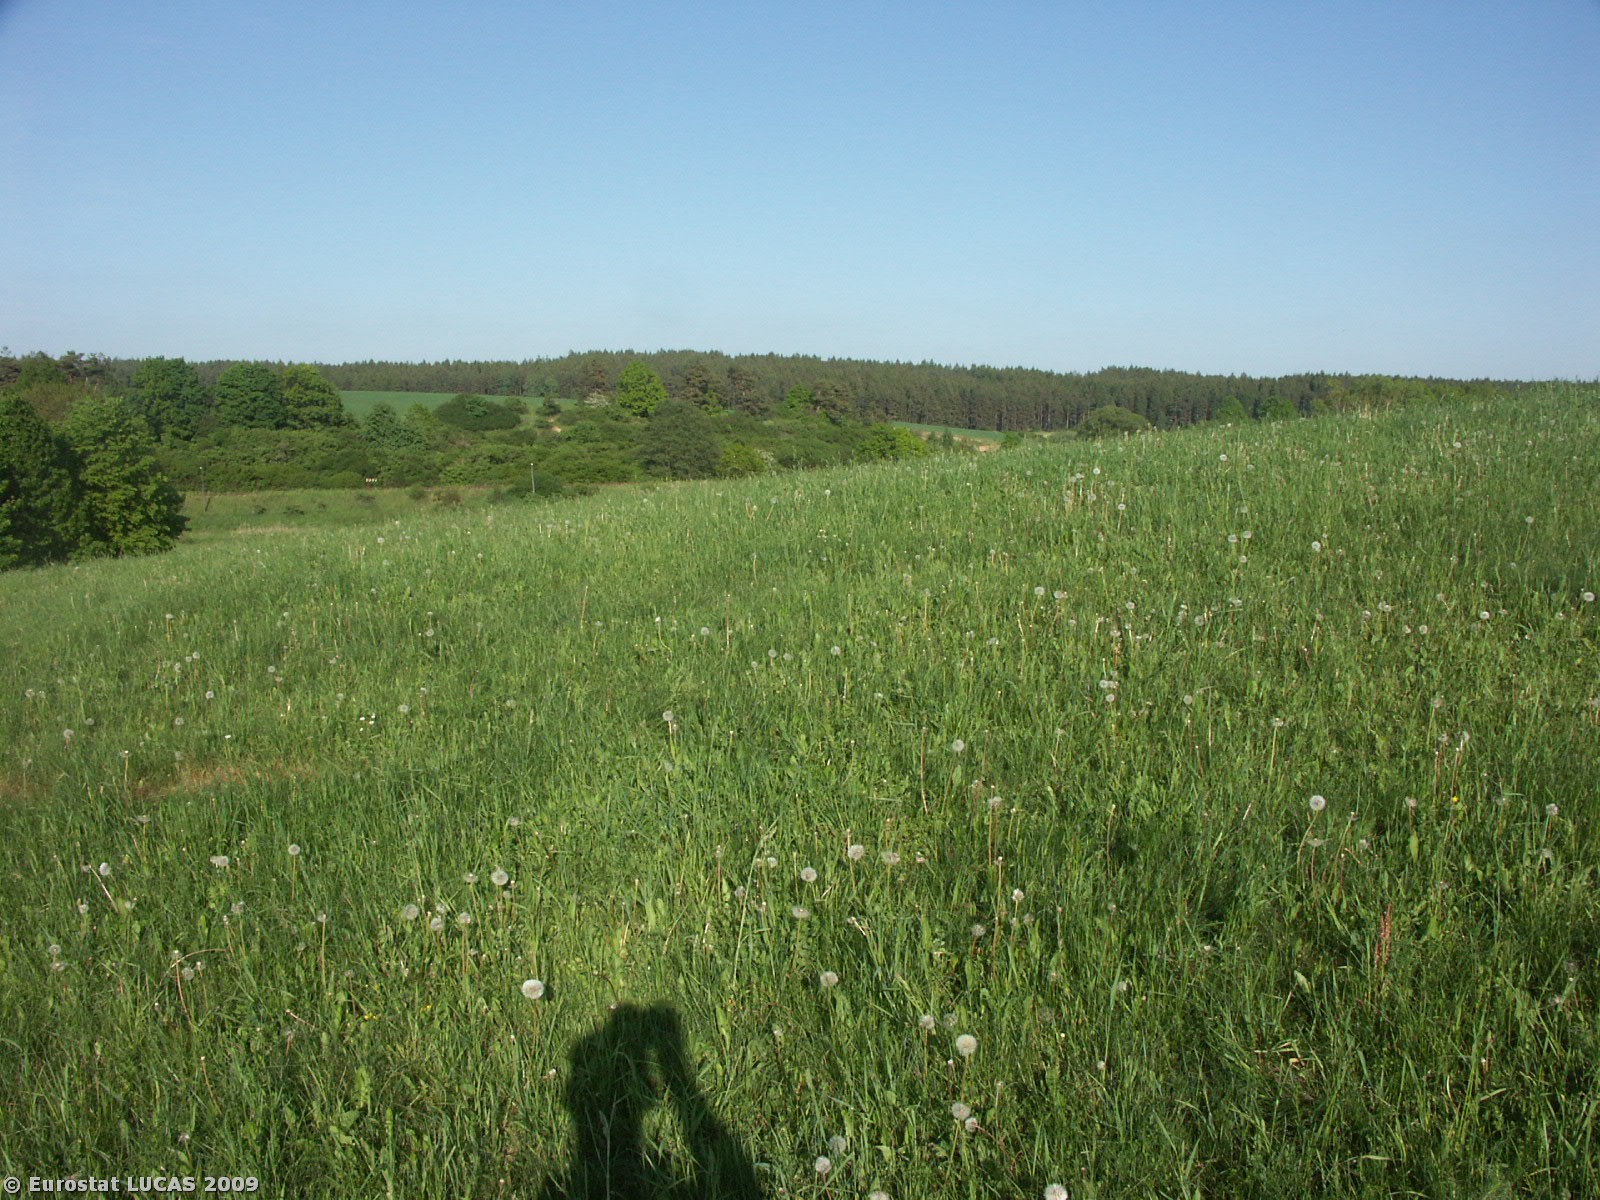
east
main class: Grassland
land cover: Grassland without tree/shrub cover
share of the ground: > 75 %
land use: Agriculture (excluding fallow land and kitchen gardens)
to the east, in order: Grassland without tree/shrub cover; Tracks; Grass margins; Tracks; Grassland without tree/shrub cover; Ditches and canals; Spontaneously vegetated surfaces; Railways; Broadleaved woodland; Tracks; Broadleaved woodland; Grassland without tree/shrub cover; Tracks; Grassland without tree/shrub cover
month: May
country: CZ
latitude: 49.0120
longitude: 15.3762
